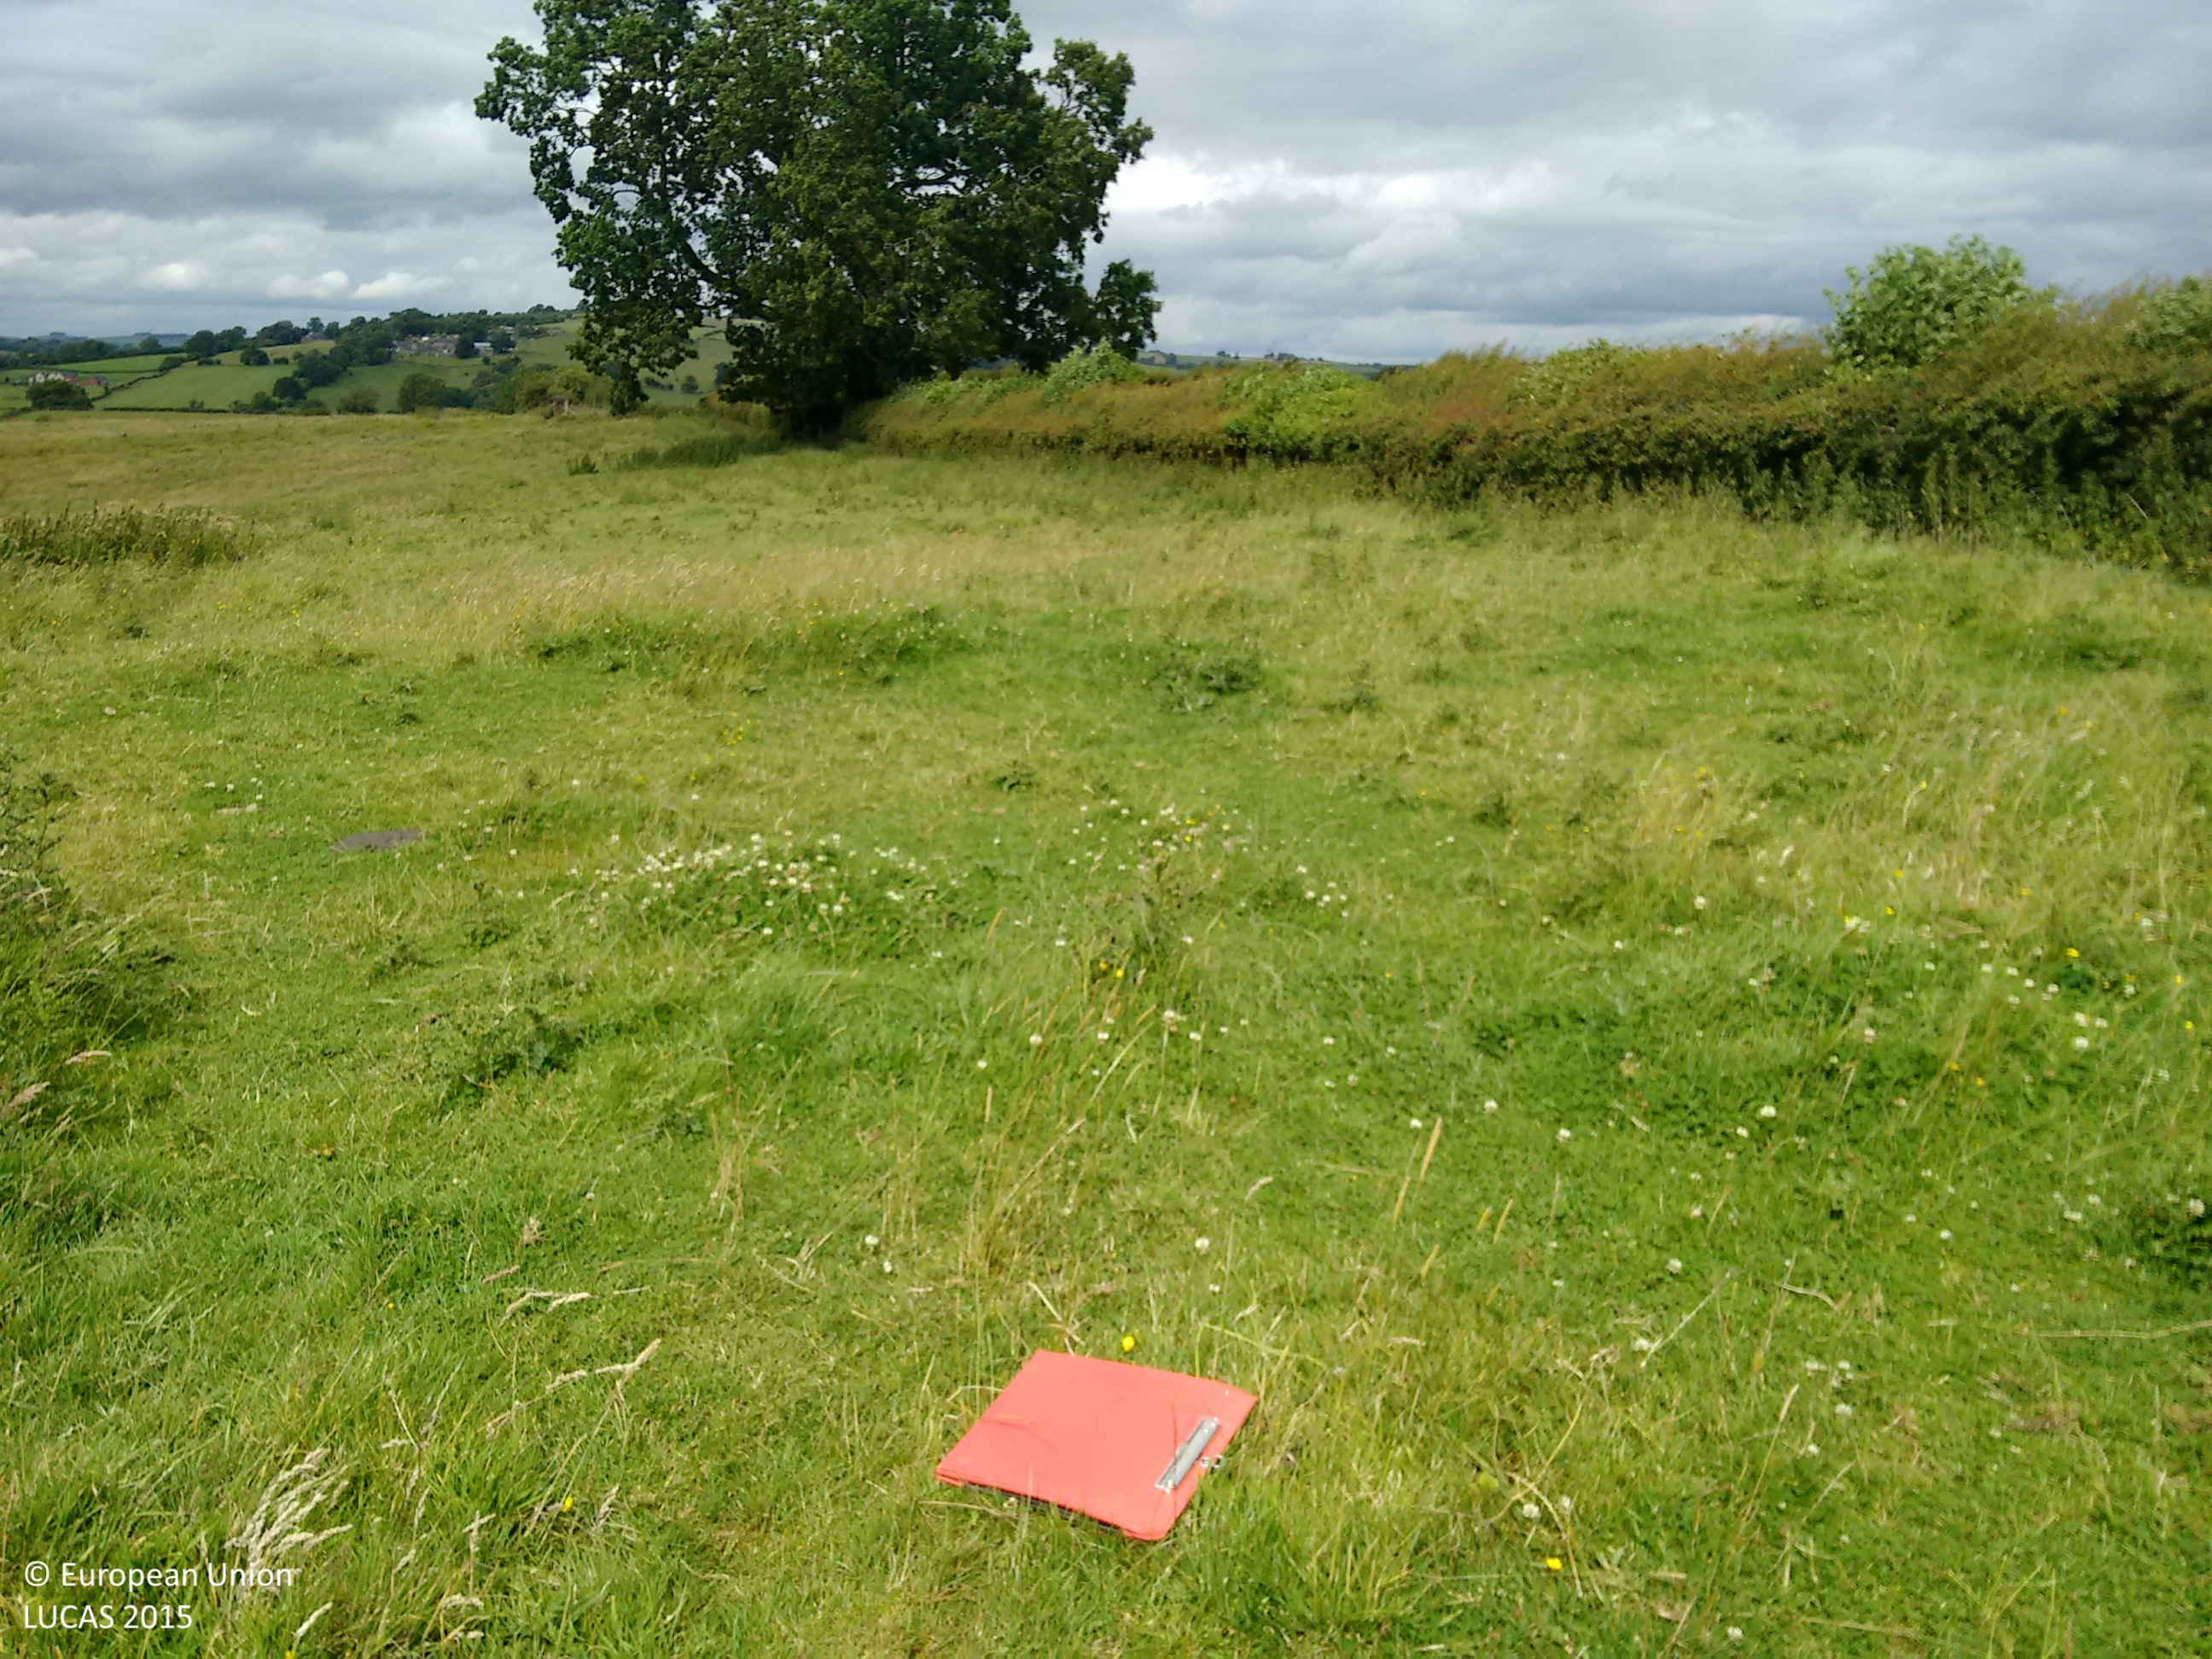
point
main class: Grassland
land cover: Grassland without tree/shrub cover
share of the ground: > 75 %
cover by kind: herbaceous plants 100 %
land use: Agriculture (excluding fallow land and kitchen gardens)
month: July
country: GB
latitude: 53.0176
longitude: -1.6652
